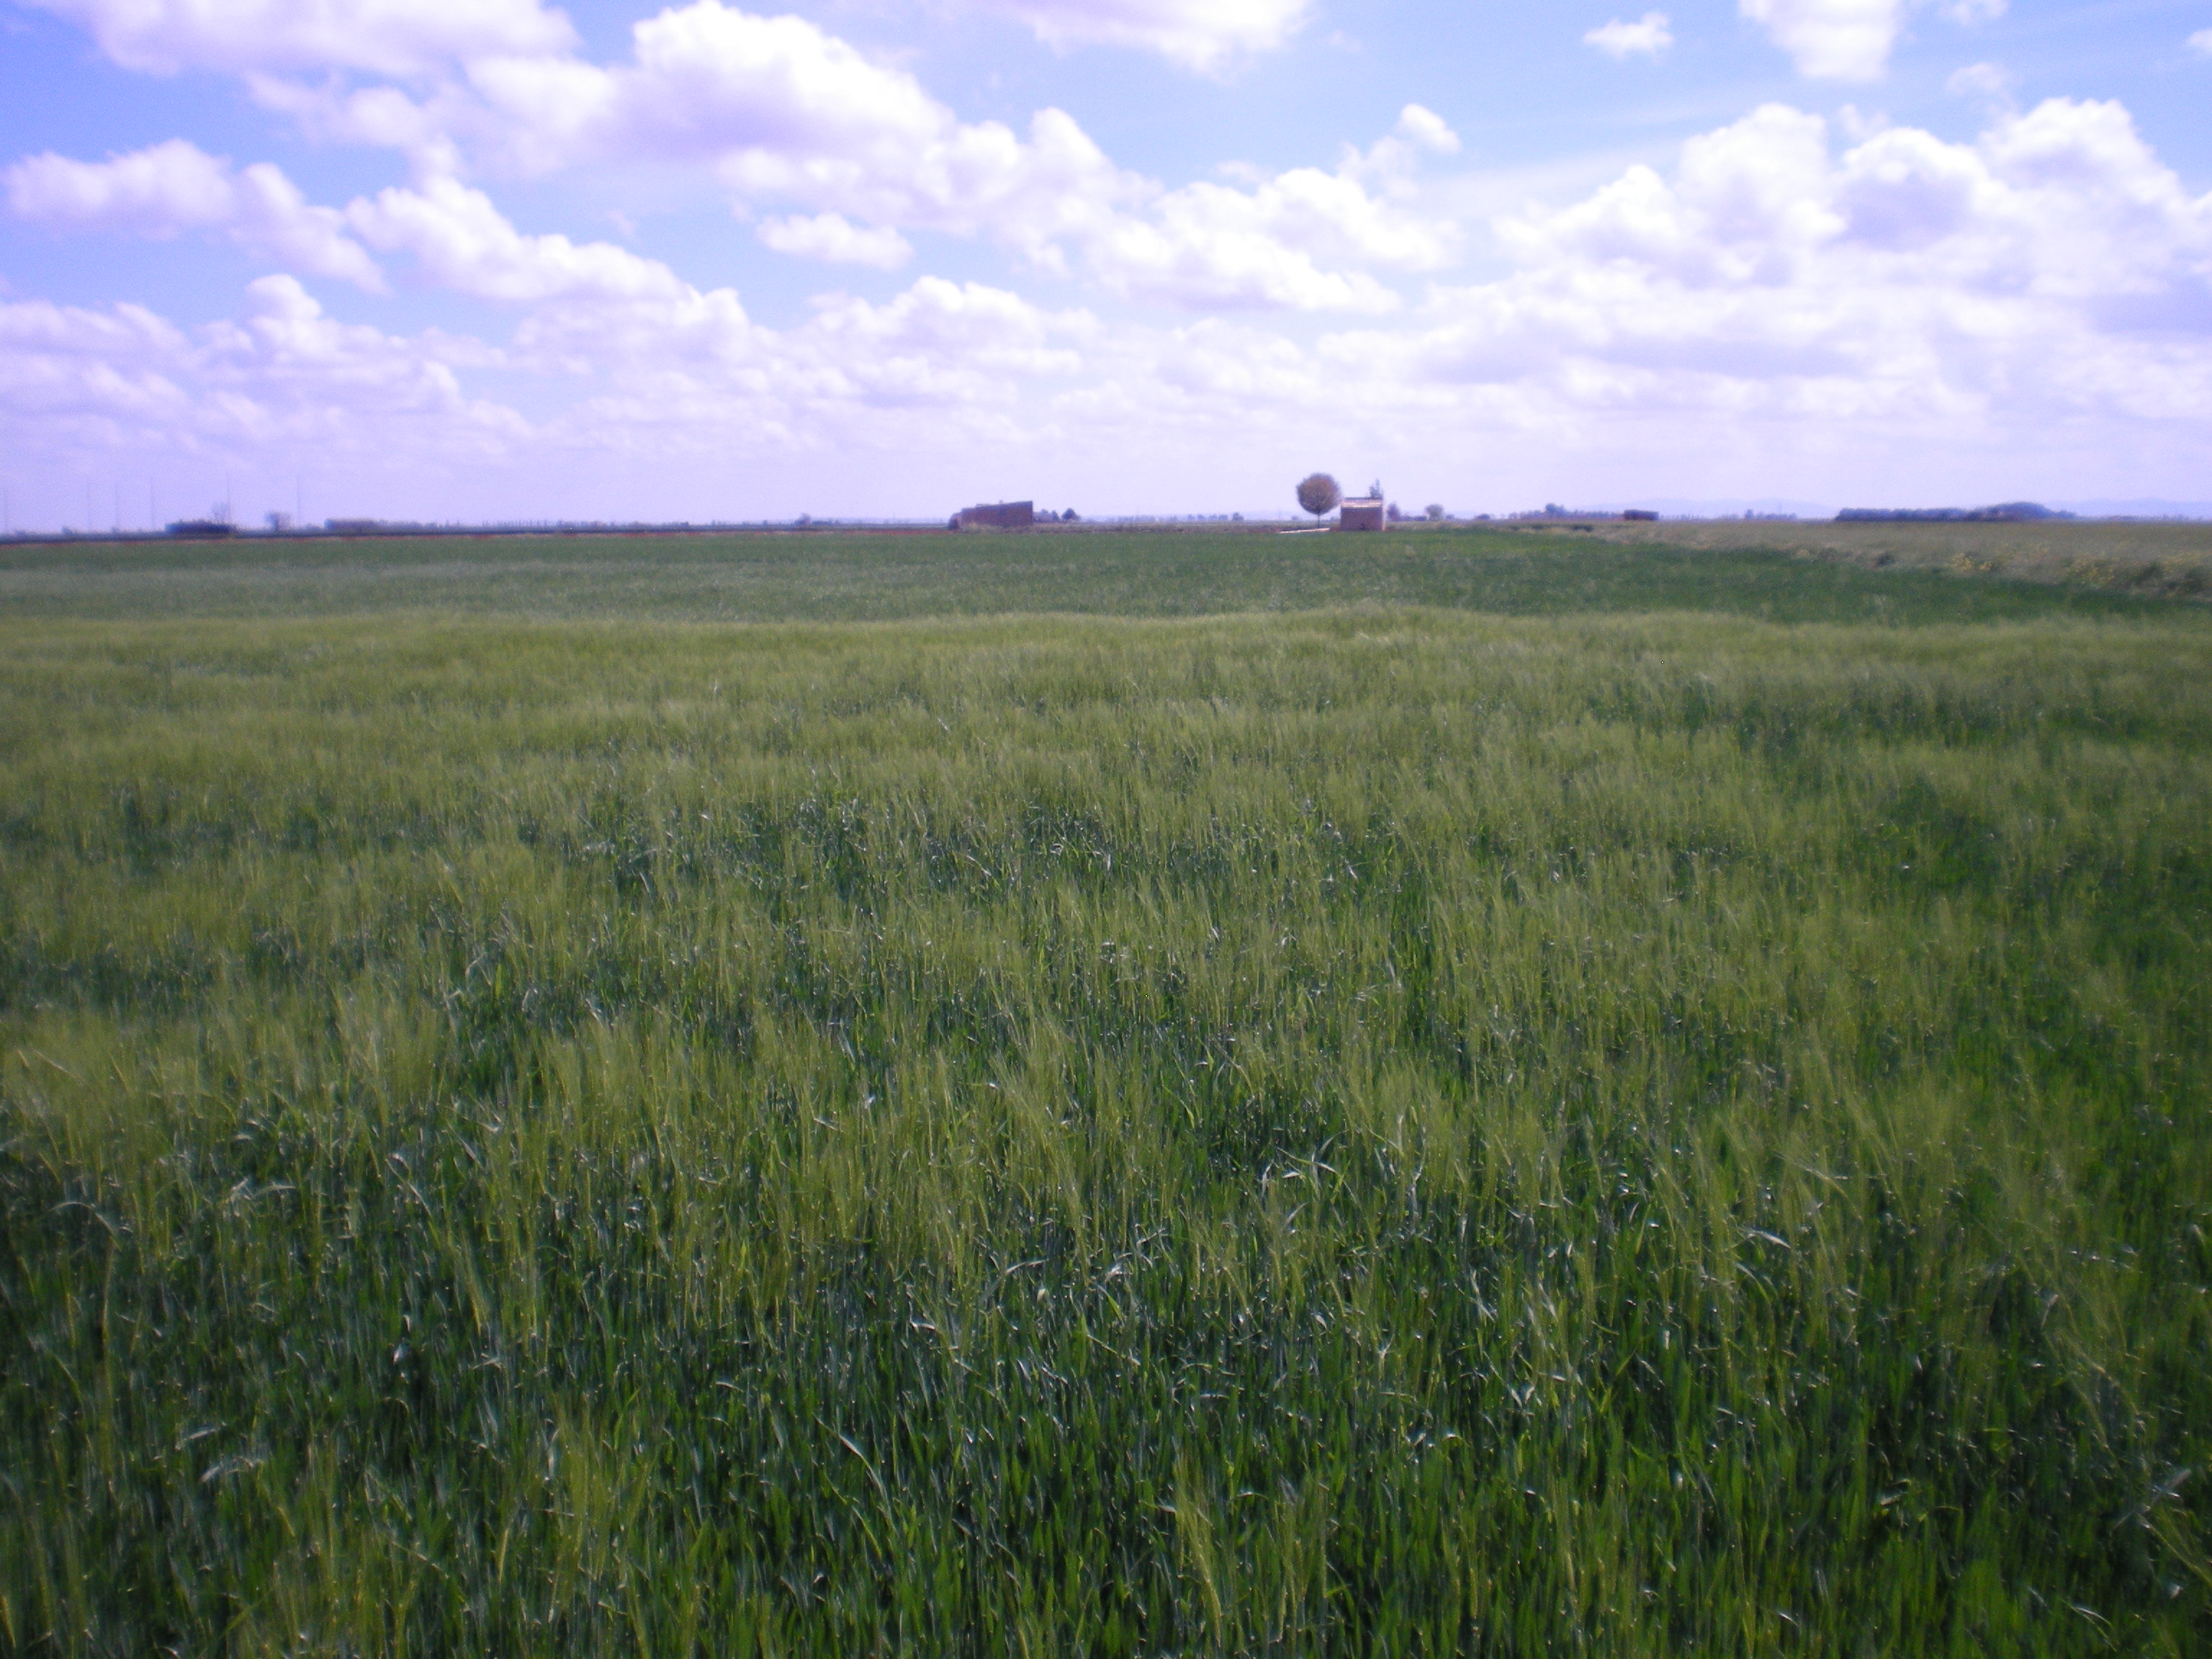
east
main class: Cropland
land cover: Barley
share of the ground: > 75 %
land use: Agriculture (excluding fallow land and kitchen gardens)
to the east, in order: Barley; Grass margins; Tracks; Grass margins; Barley; Grass margins; Other bare soil
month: April
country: ES
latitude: 38.9736
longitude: -3.5551
